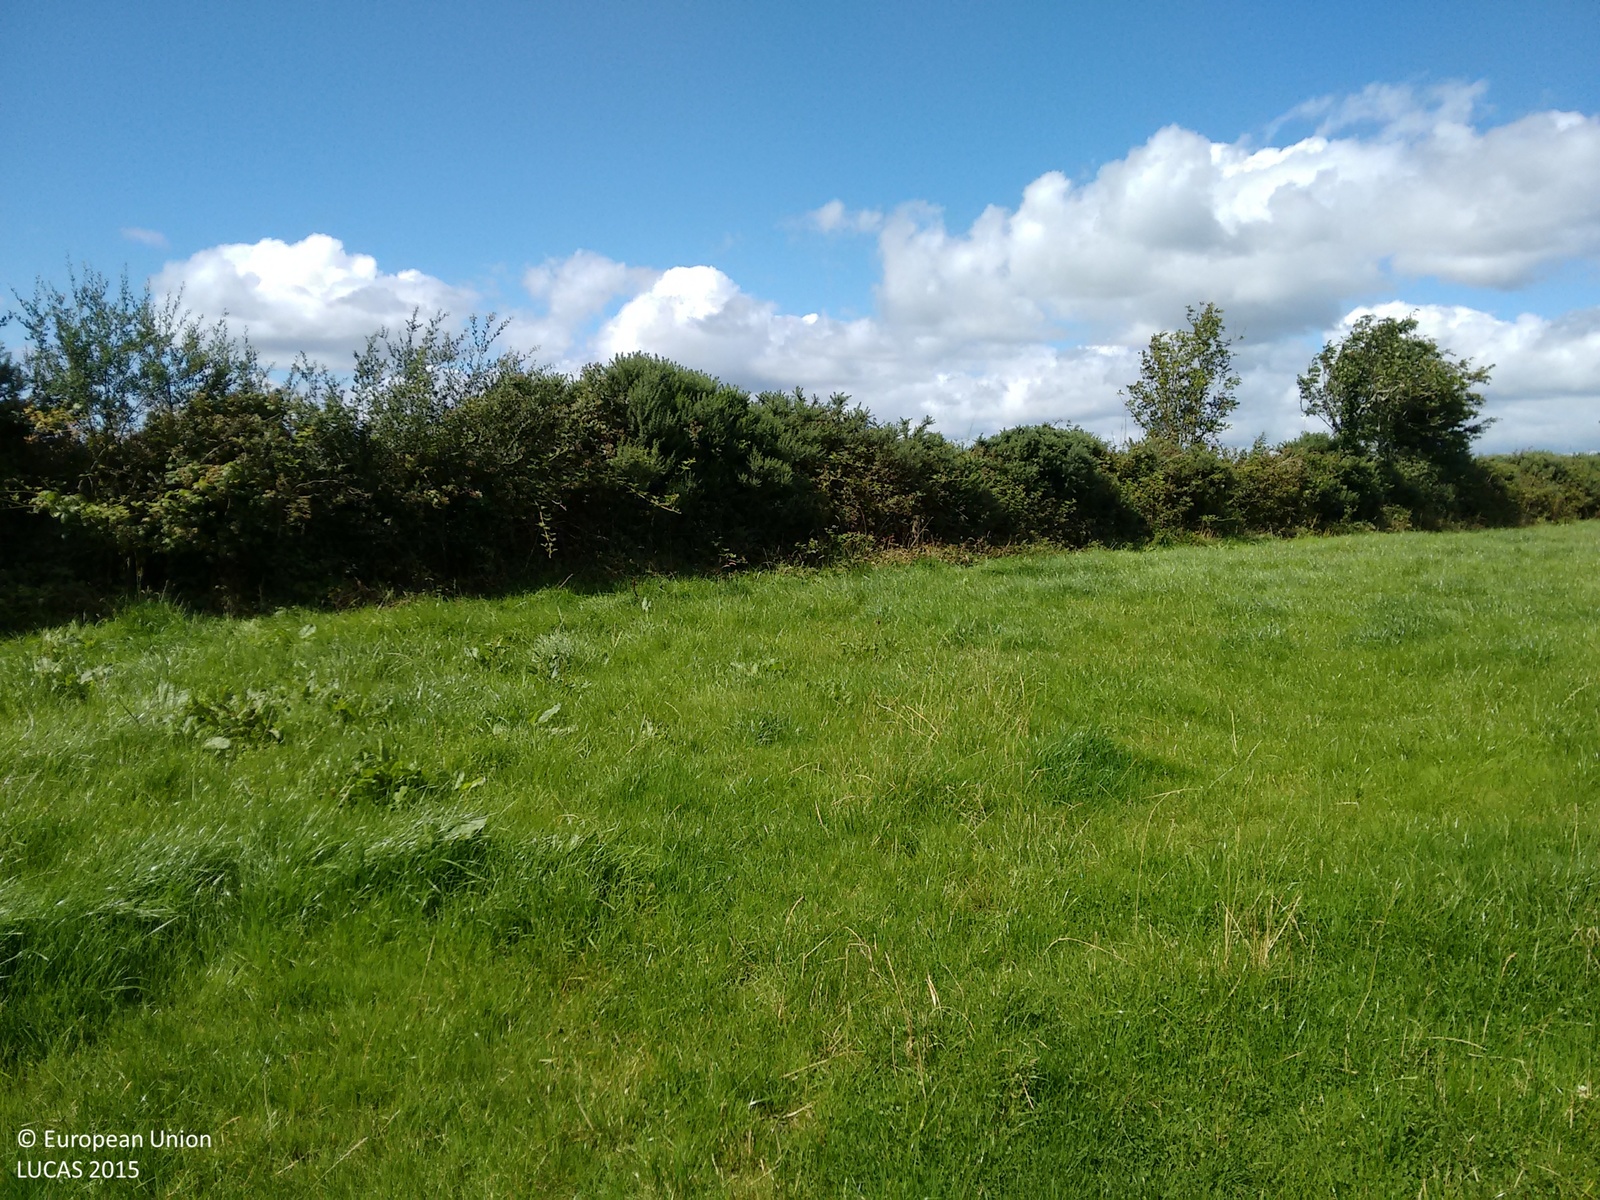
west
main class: Woodland
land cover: Broadleaved woodland
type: mesophytic deciduous forest
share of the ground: > 75 %
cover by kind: broadleaved forest trees 85 %, shrubs 15 %
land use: Forestry
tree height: > 5 m
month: August
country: IE
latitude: 52.4034
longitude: -7.1540
